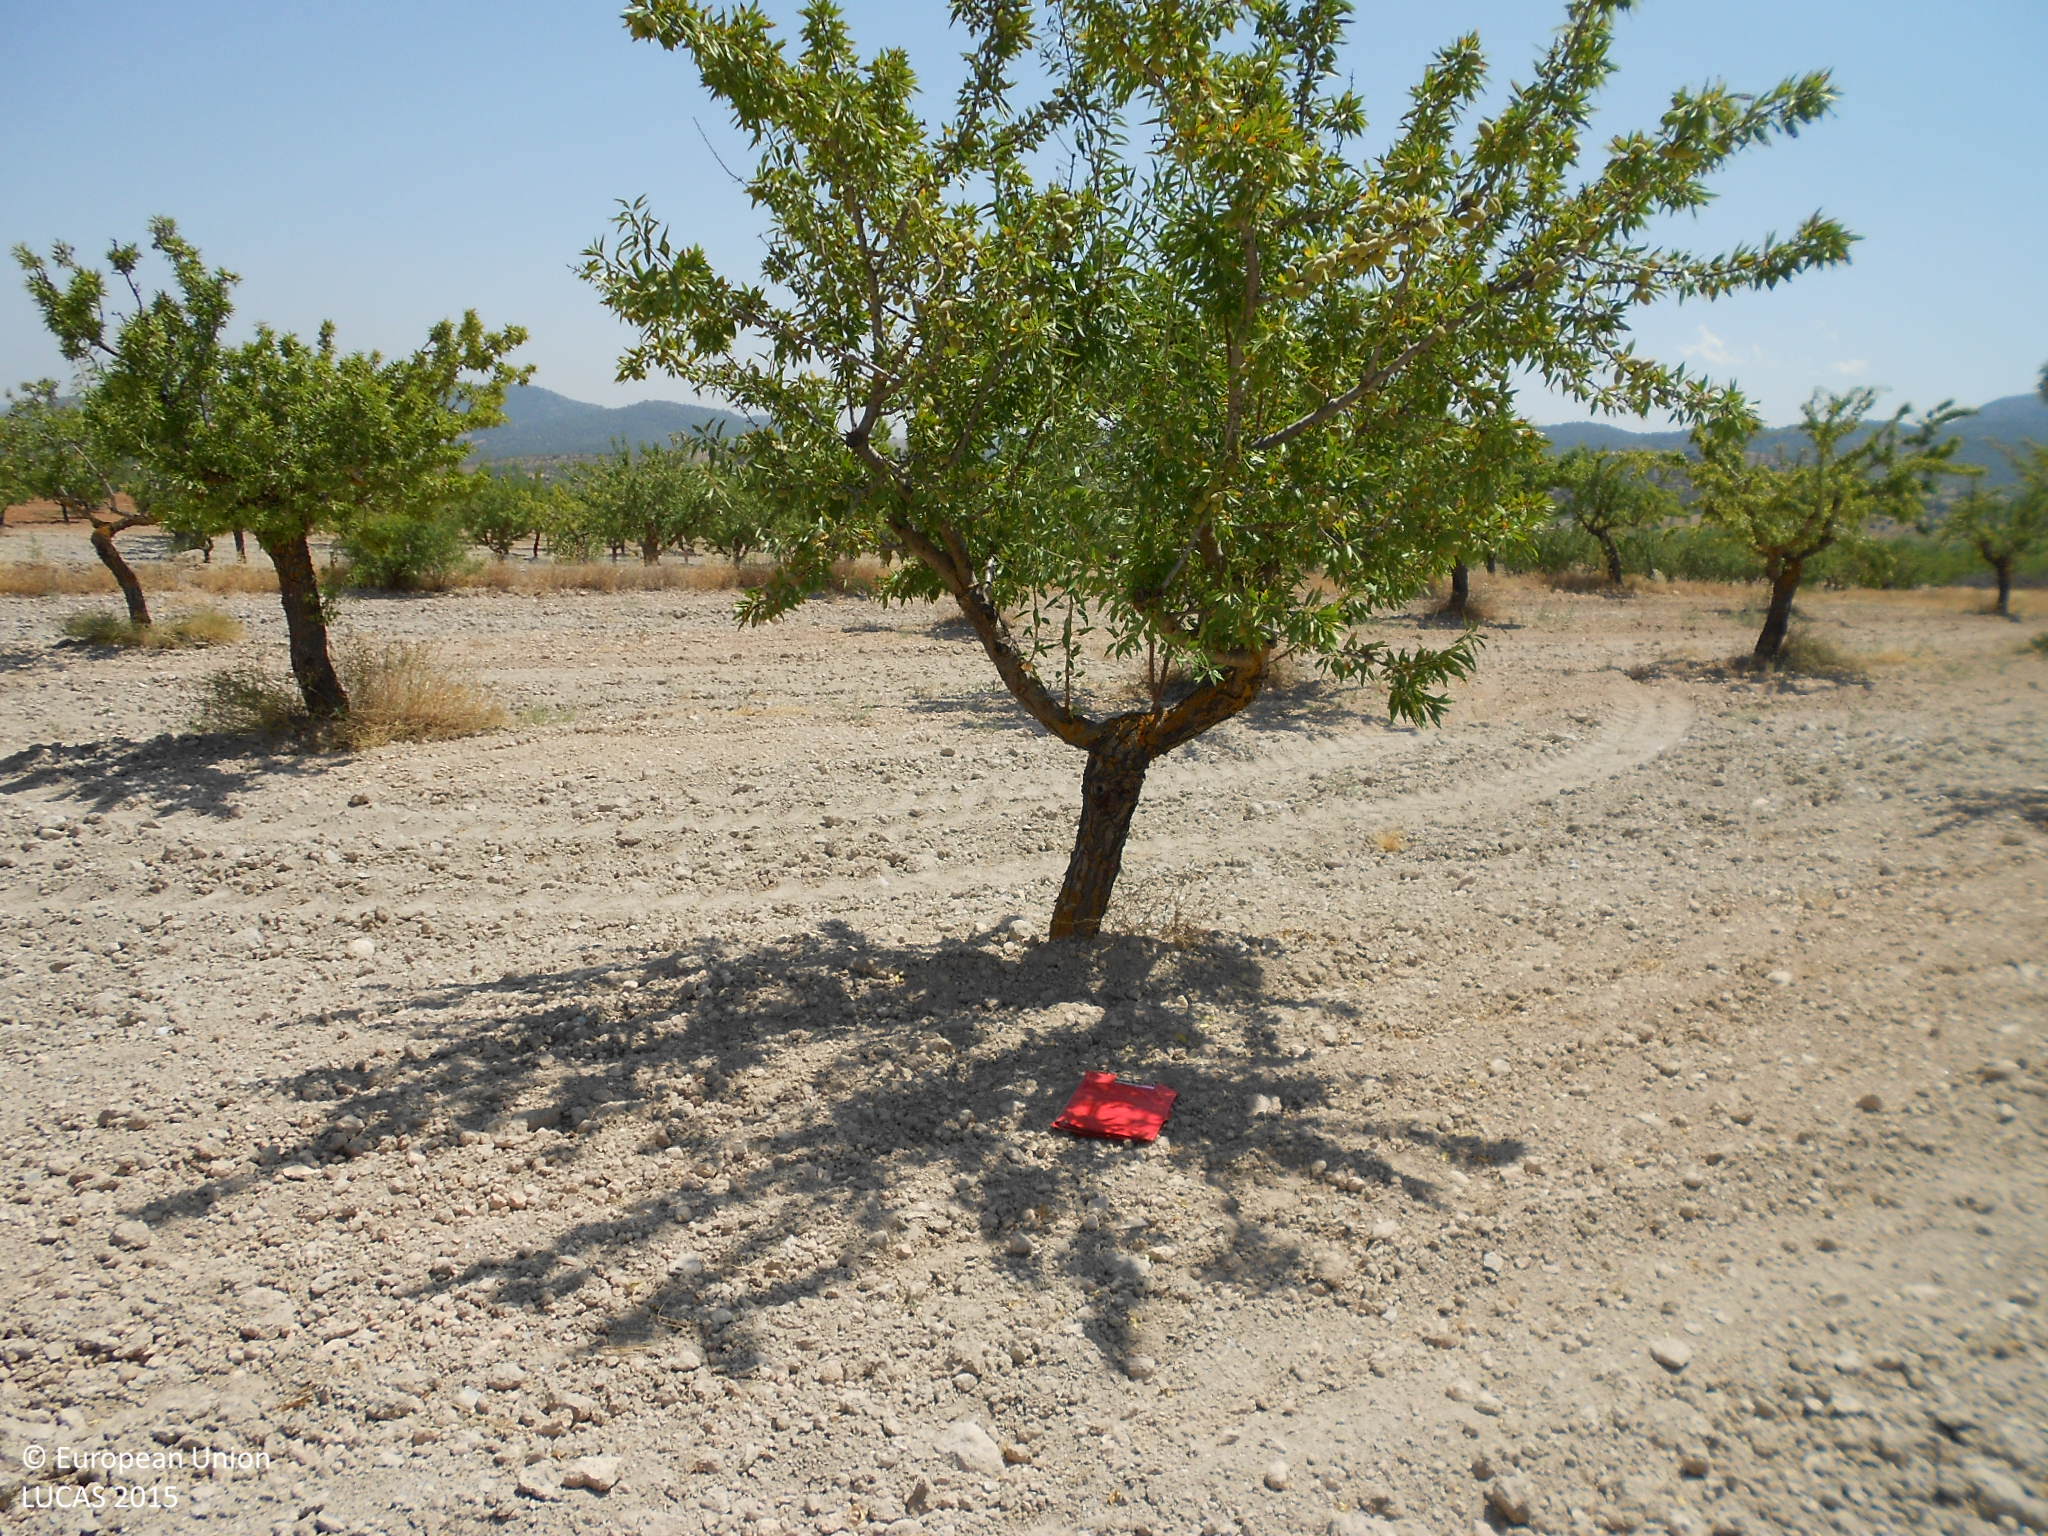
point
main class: Cropland
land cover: Nuts trees
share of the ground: 25 - 50 %
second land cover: Other bare soil
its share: > 75 %
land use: Agriculture (excluding fallow land and kitchen gardens)
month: July
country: ES
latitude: 37.4986
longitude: -2.4157
